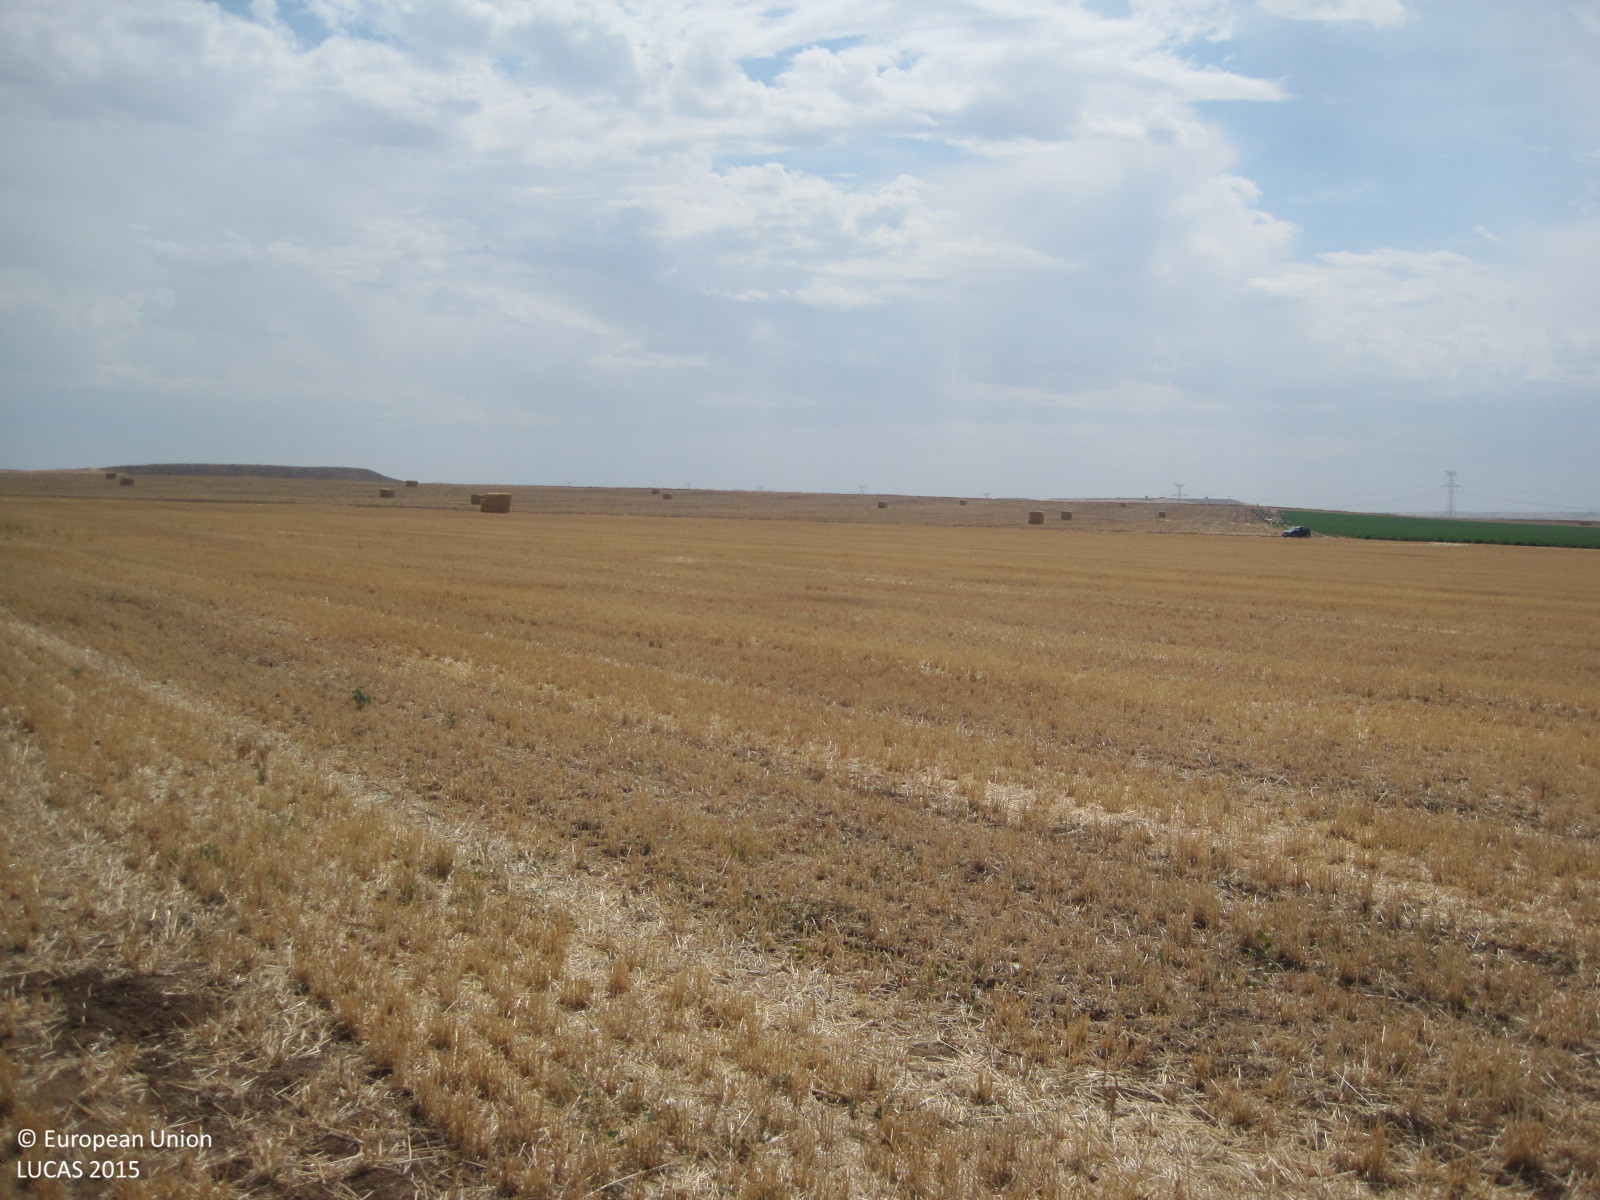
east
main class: Cropland
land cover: Barley
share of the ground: < 10 %
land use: Agriculture (excluding fallow land and kitchen gardens)
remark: Harvested field
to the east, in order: Barley; Grass margins; Barley
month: July
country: ES
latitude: 39.9777
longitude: -4.2189
